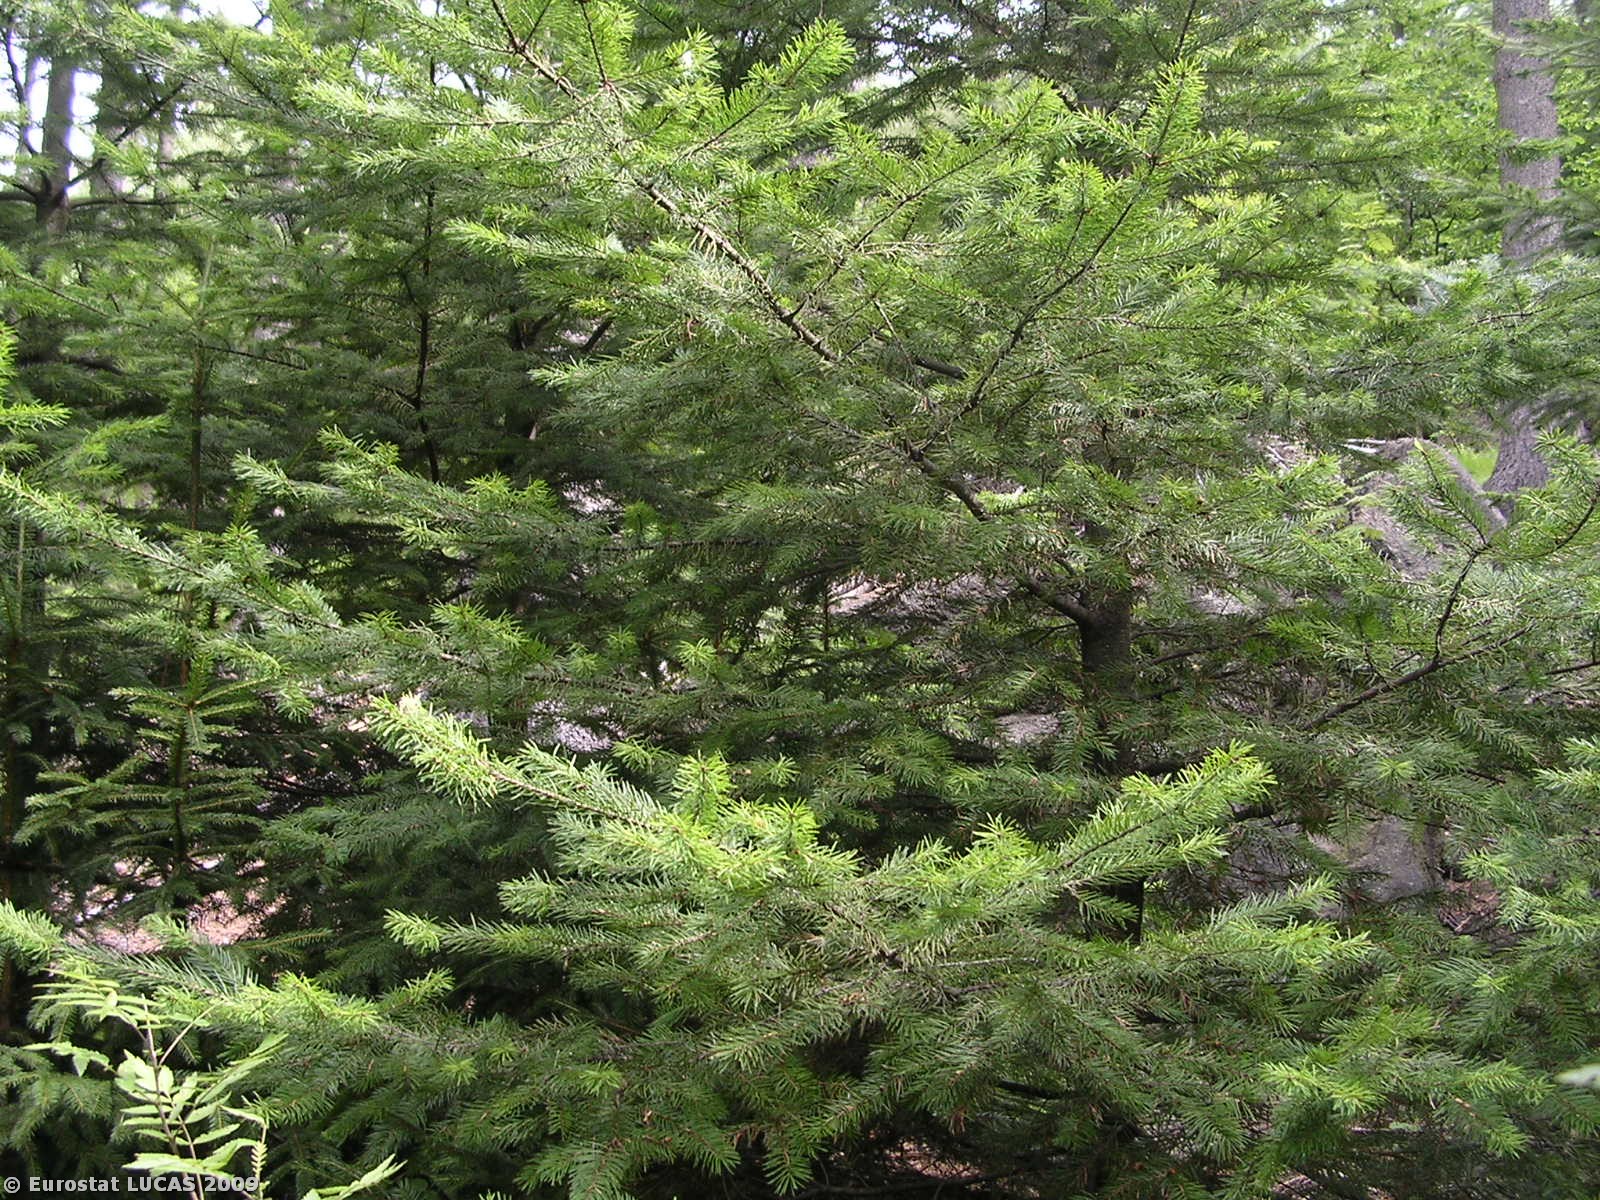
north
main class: Woodland
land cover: Mixed woodland
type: hemiboreal forest and nemoral coniferous forest and mixed broadleaved-coniferous forest
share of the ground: > 75 %
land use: Forestry
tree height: > 5 m
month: July
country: CZ
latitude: 50.7910
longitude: 15.0959
